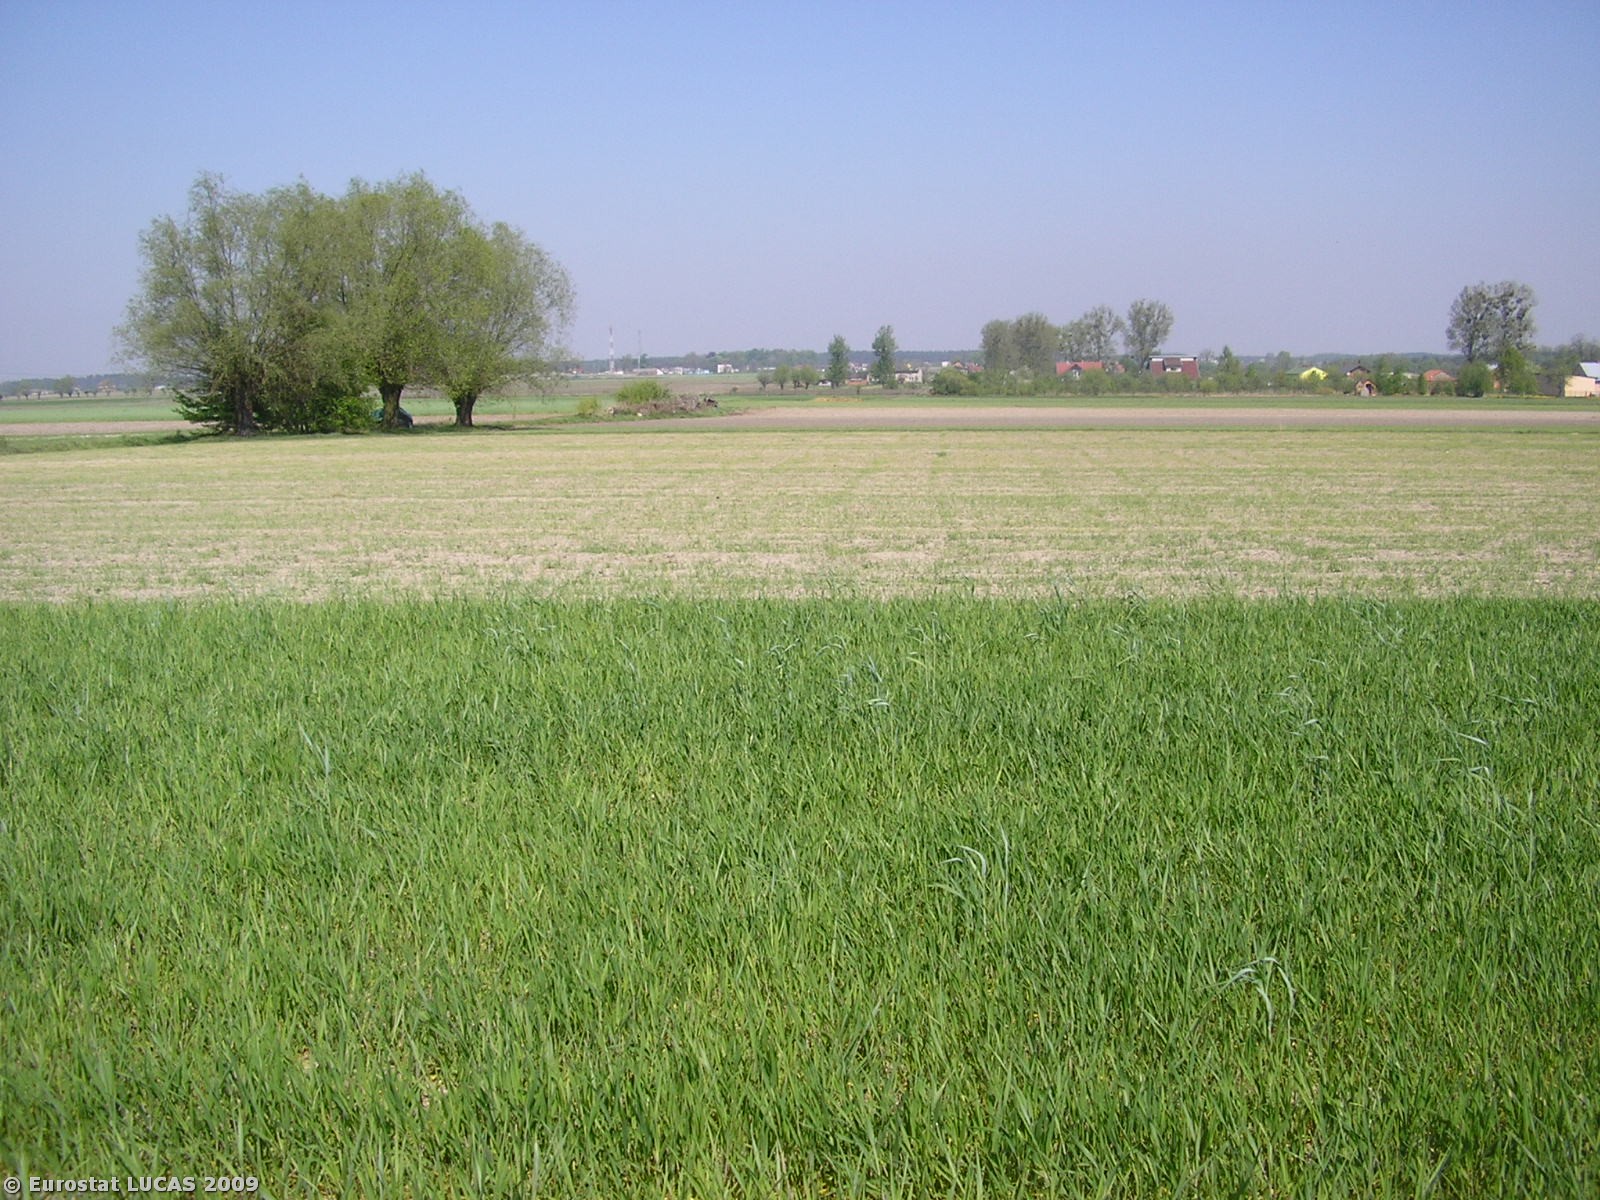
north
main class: Cropland
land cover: Triticale
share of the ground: 50 - 75 %
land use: Agriculture (excluding fallow land and kitchen gardens)
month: April
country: PL
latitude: 52.2820
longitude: 20.1929
